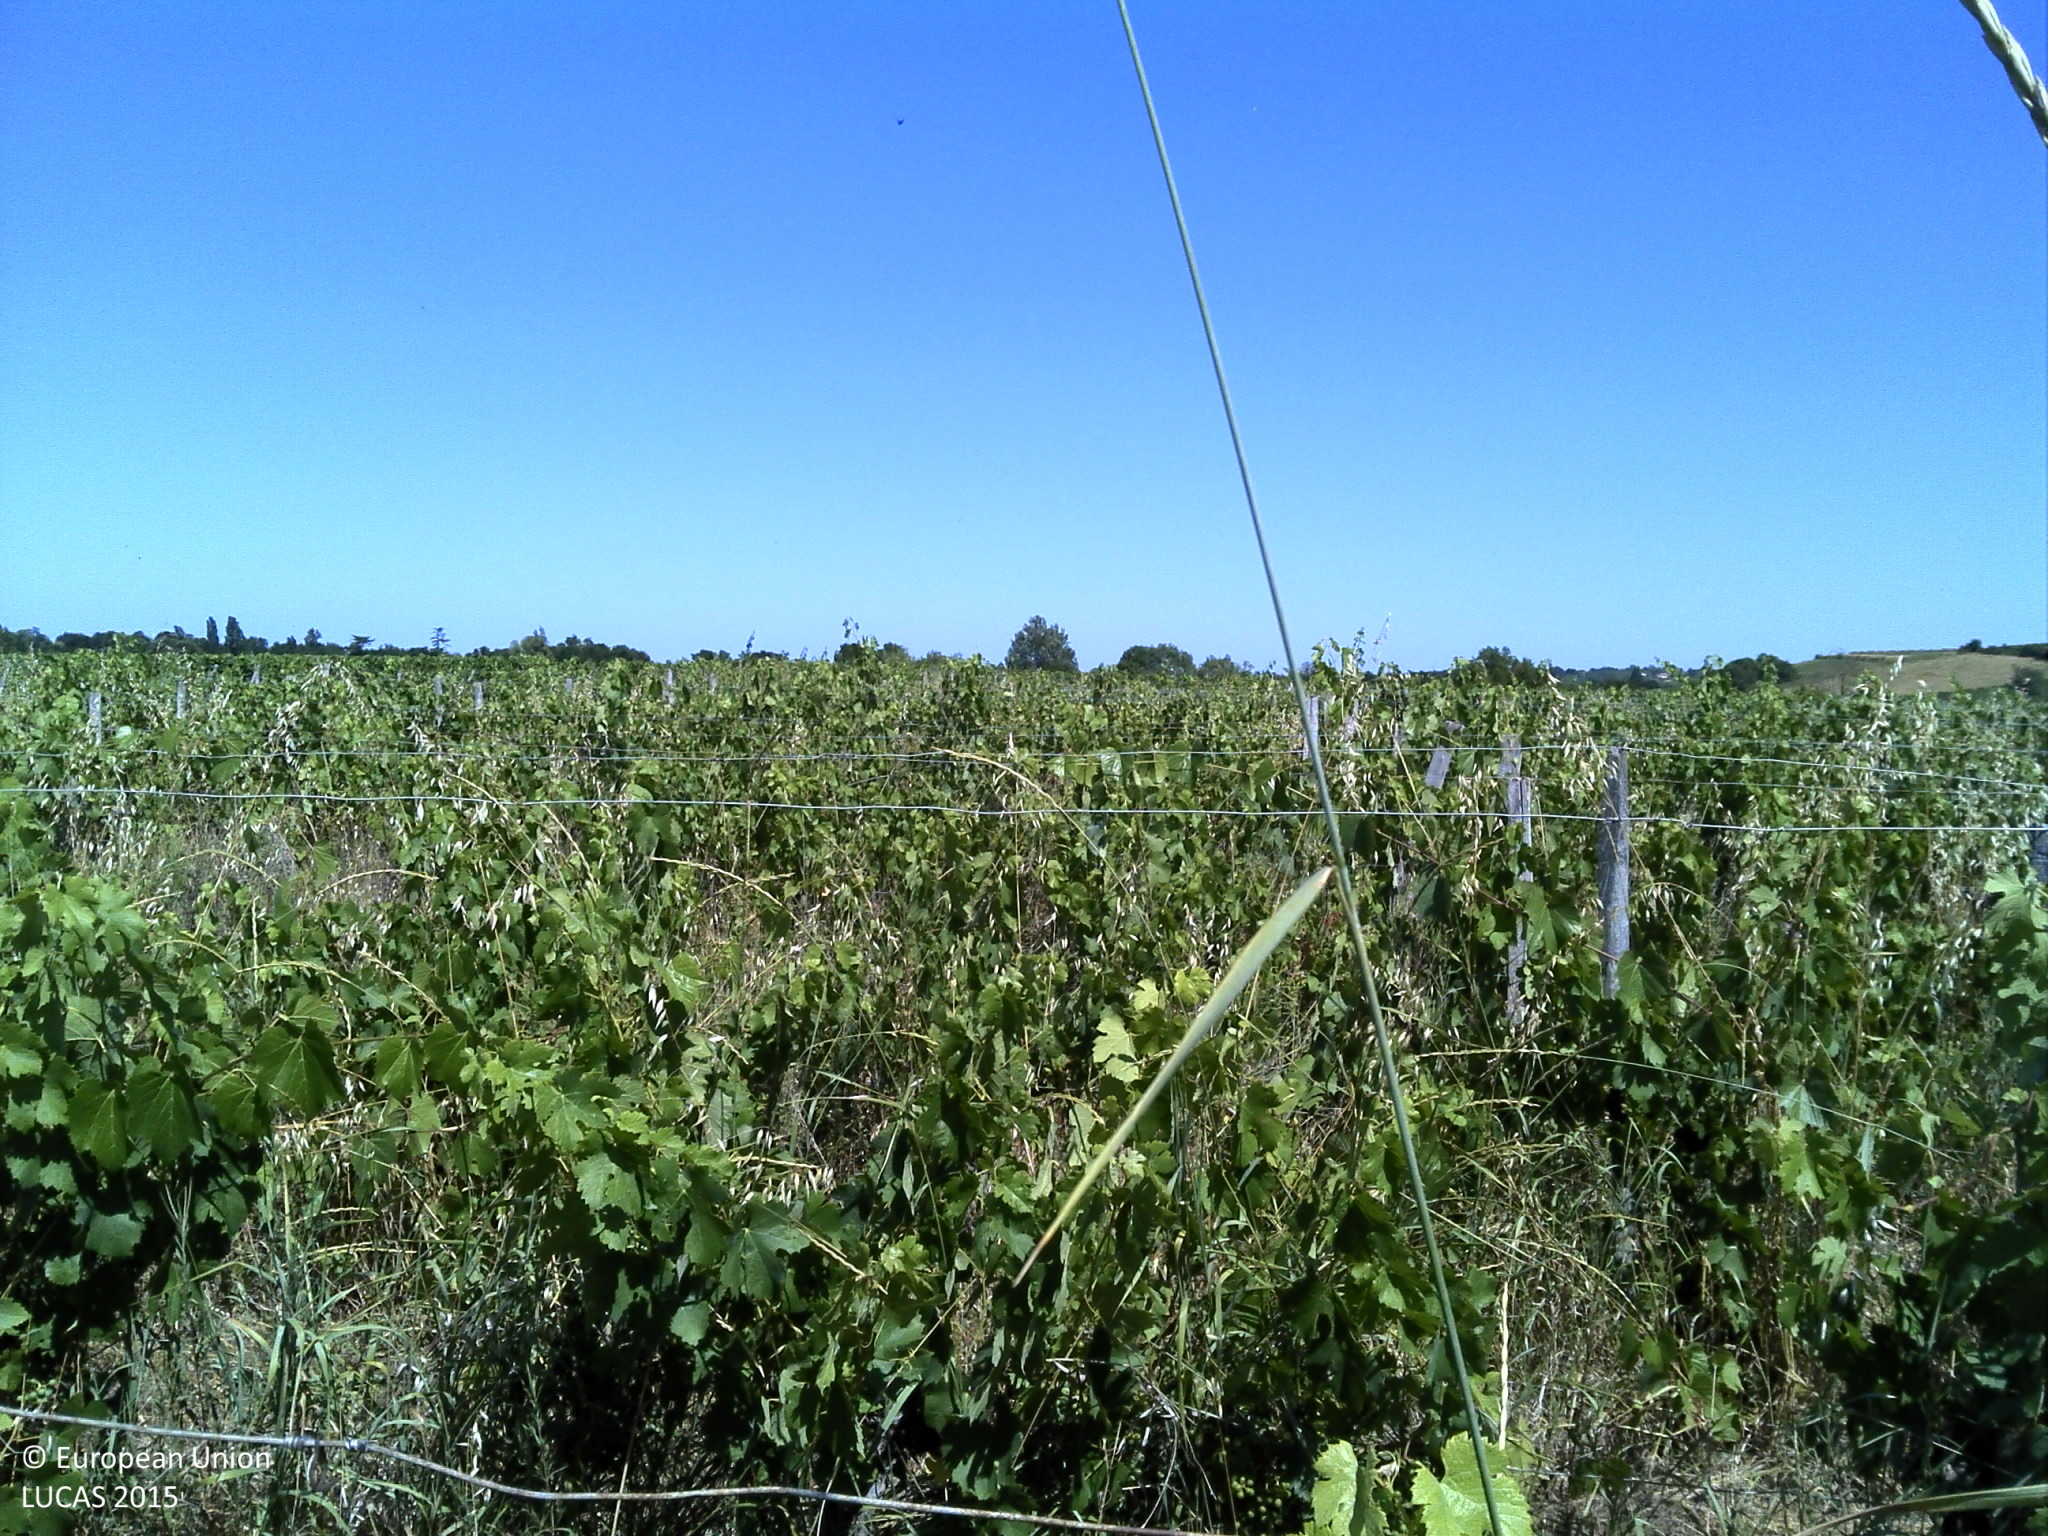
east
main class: Cropland
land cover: Vineyards
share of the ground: 10 - 25 %
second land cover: Grassland without tree/shrub cover
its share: > 75 %
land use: Agriculture (excluding fallow land and kitchen gardens)
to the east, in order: Vineyards; Grassland without tree/shrub cover; Tracks; Vineyards; Tracks; Vineyards; Tracks; Broadleaved woodland; Grassland without tree/shrub cover
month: July
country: FR
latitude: 44.8947
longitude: -0.4390
